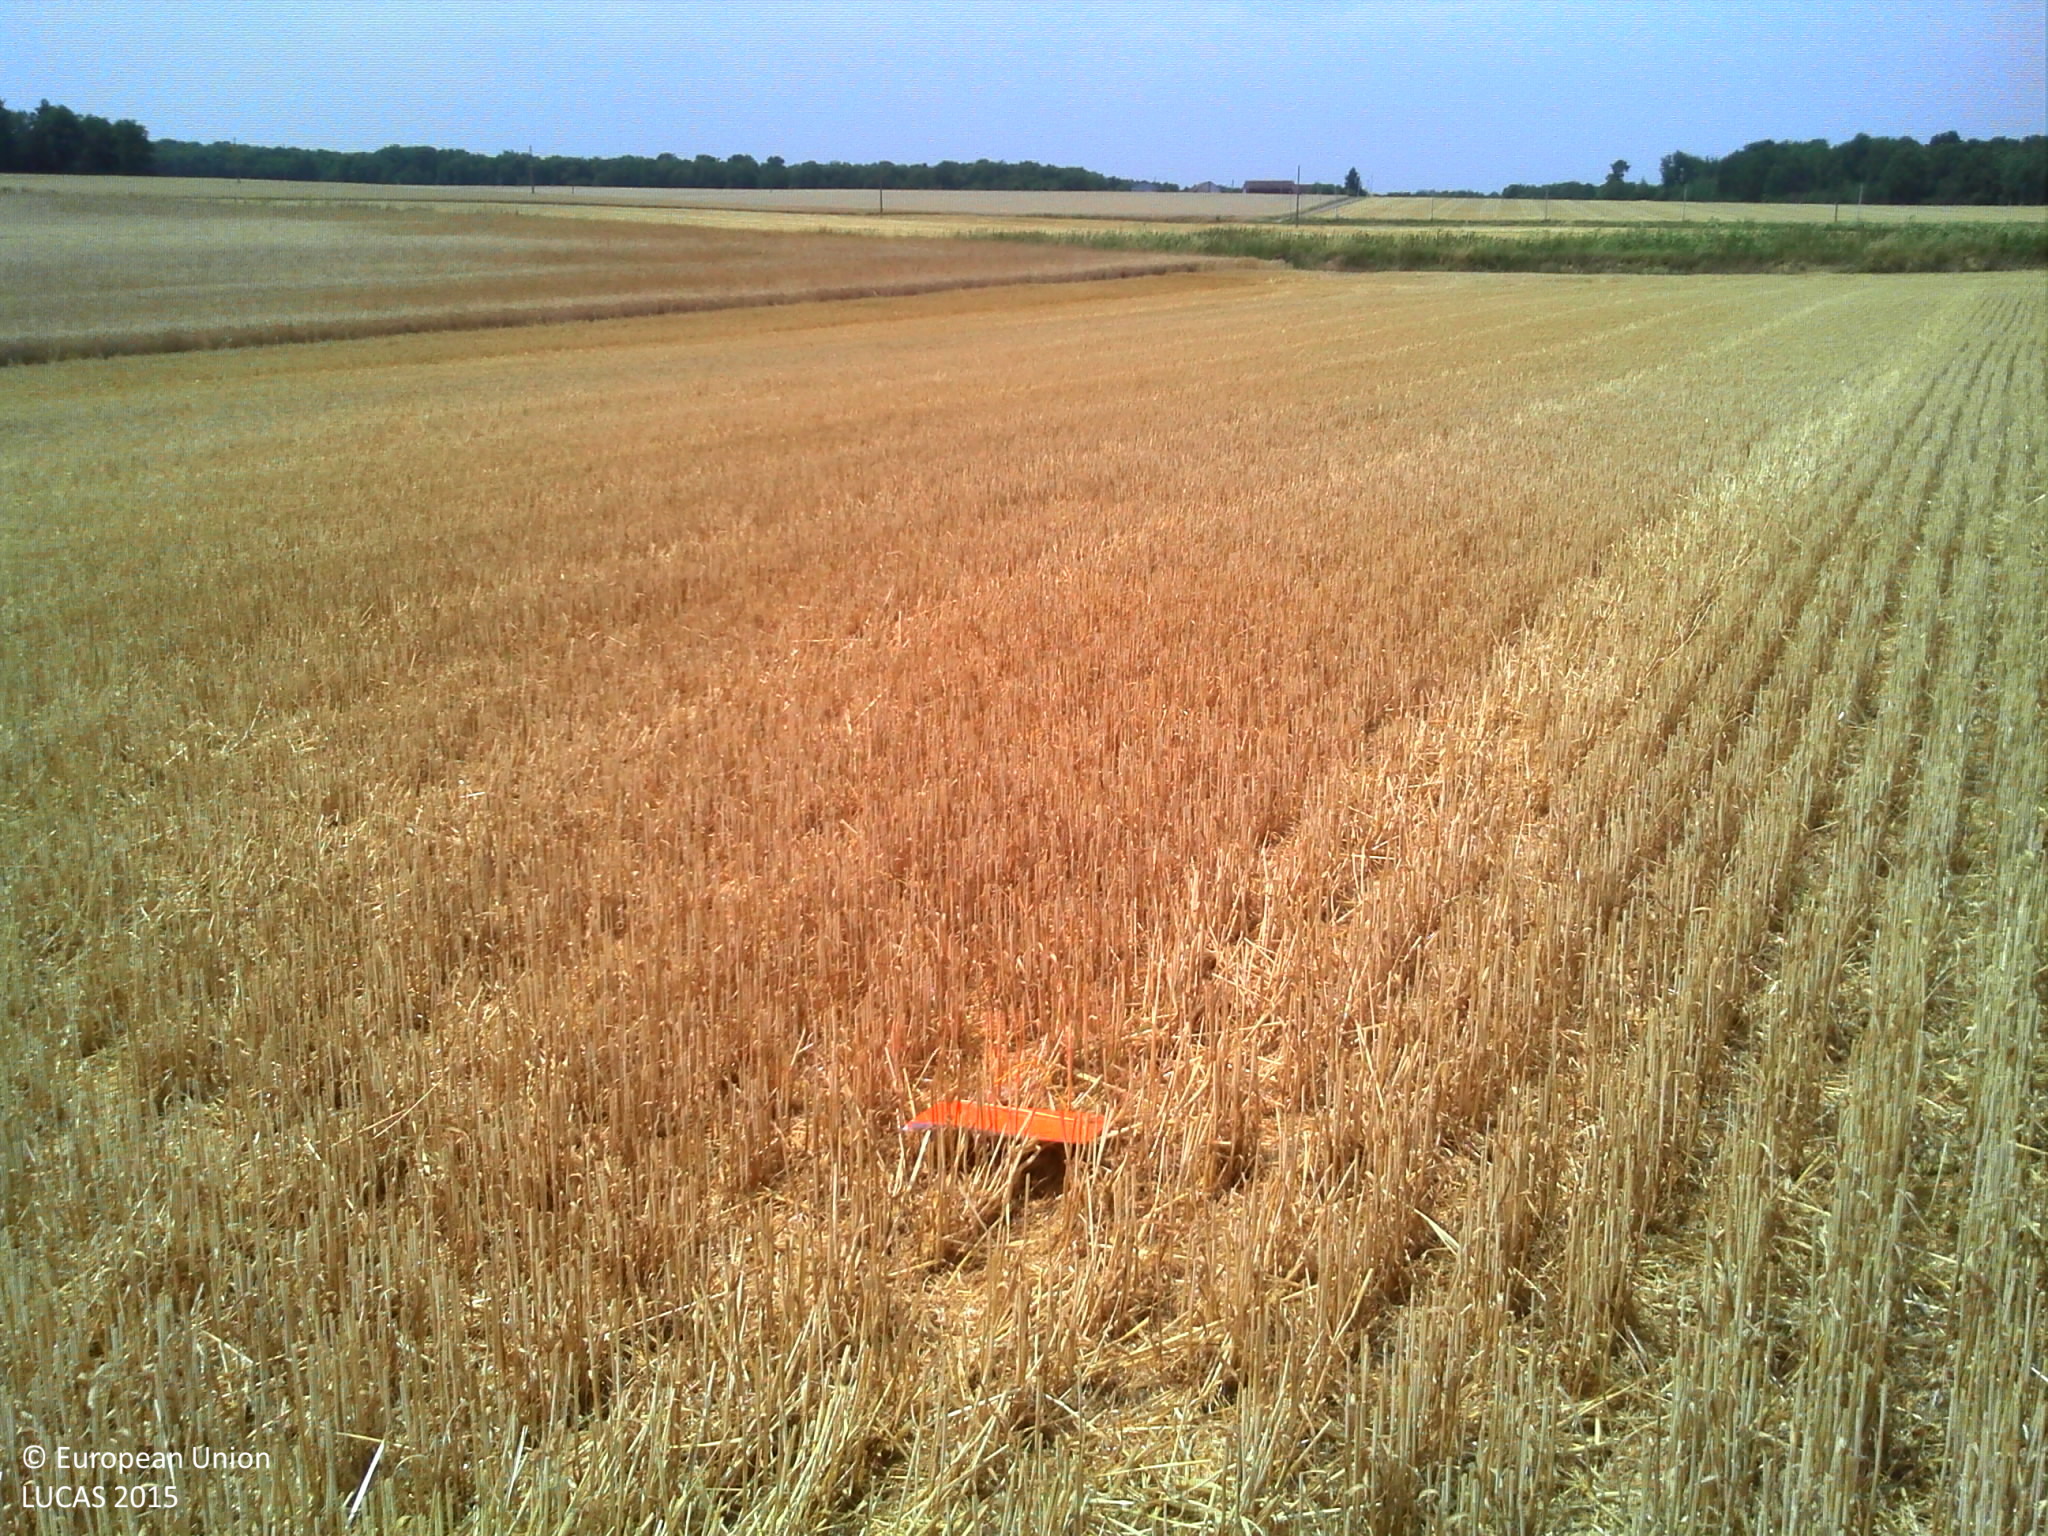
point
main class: Cropland
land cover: Barley
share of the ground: > 75 %
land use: Agriculture (excluding fallow land and kitchen gardens)
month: July
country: FR
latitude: 47.9675
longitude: 3.0416
